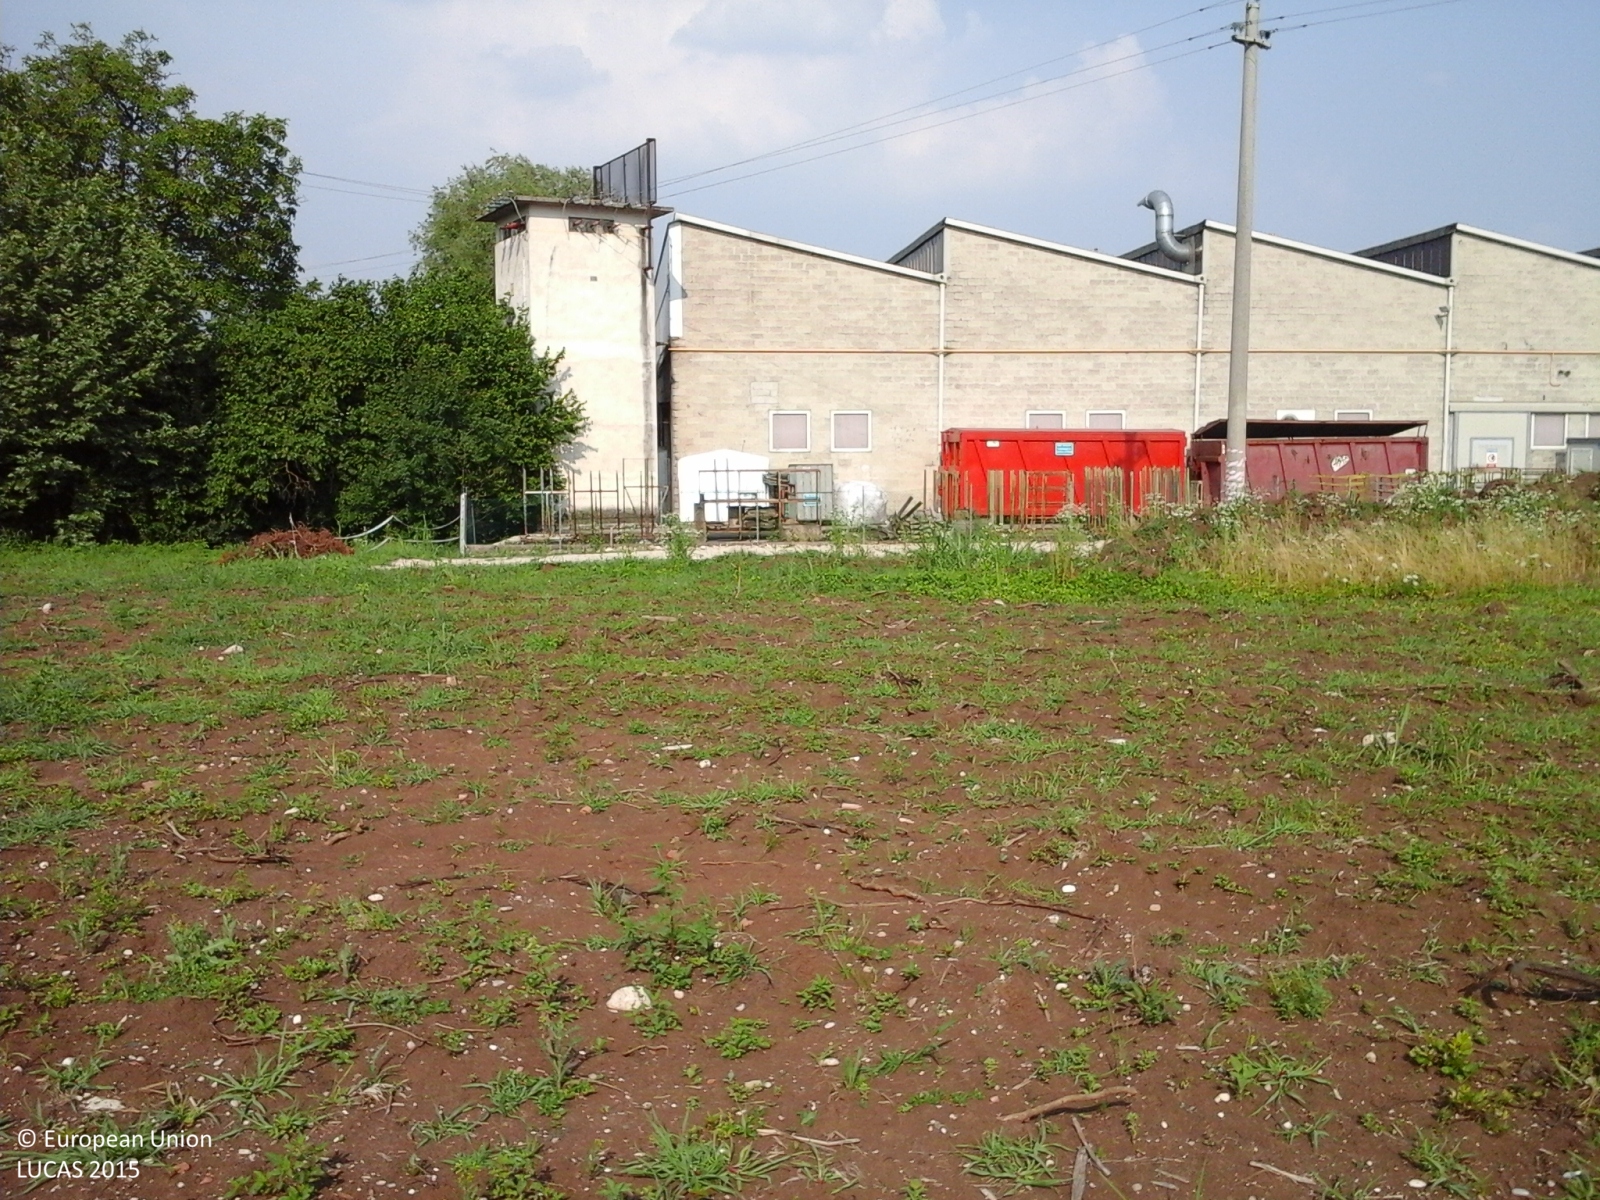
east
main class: Grassland
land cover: Spontaneously vegetated surfaces
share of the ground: 25 - 50 %
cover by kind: consolidated bare surface 60 %, herbaceous plants 40 %
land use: Fallow land
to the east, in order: Spontaneously vegetated surfaces; Artificial constructions in urban areas; Grassland without tree/shrub cover; Maize; Other fresh vegetables; Other fruit trees and berries; Vineyards; Arable land (only in case pi); Artificial constructions in urban areas
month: June
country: IT
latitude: 45.7261
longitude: 11.6294
